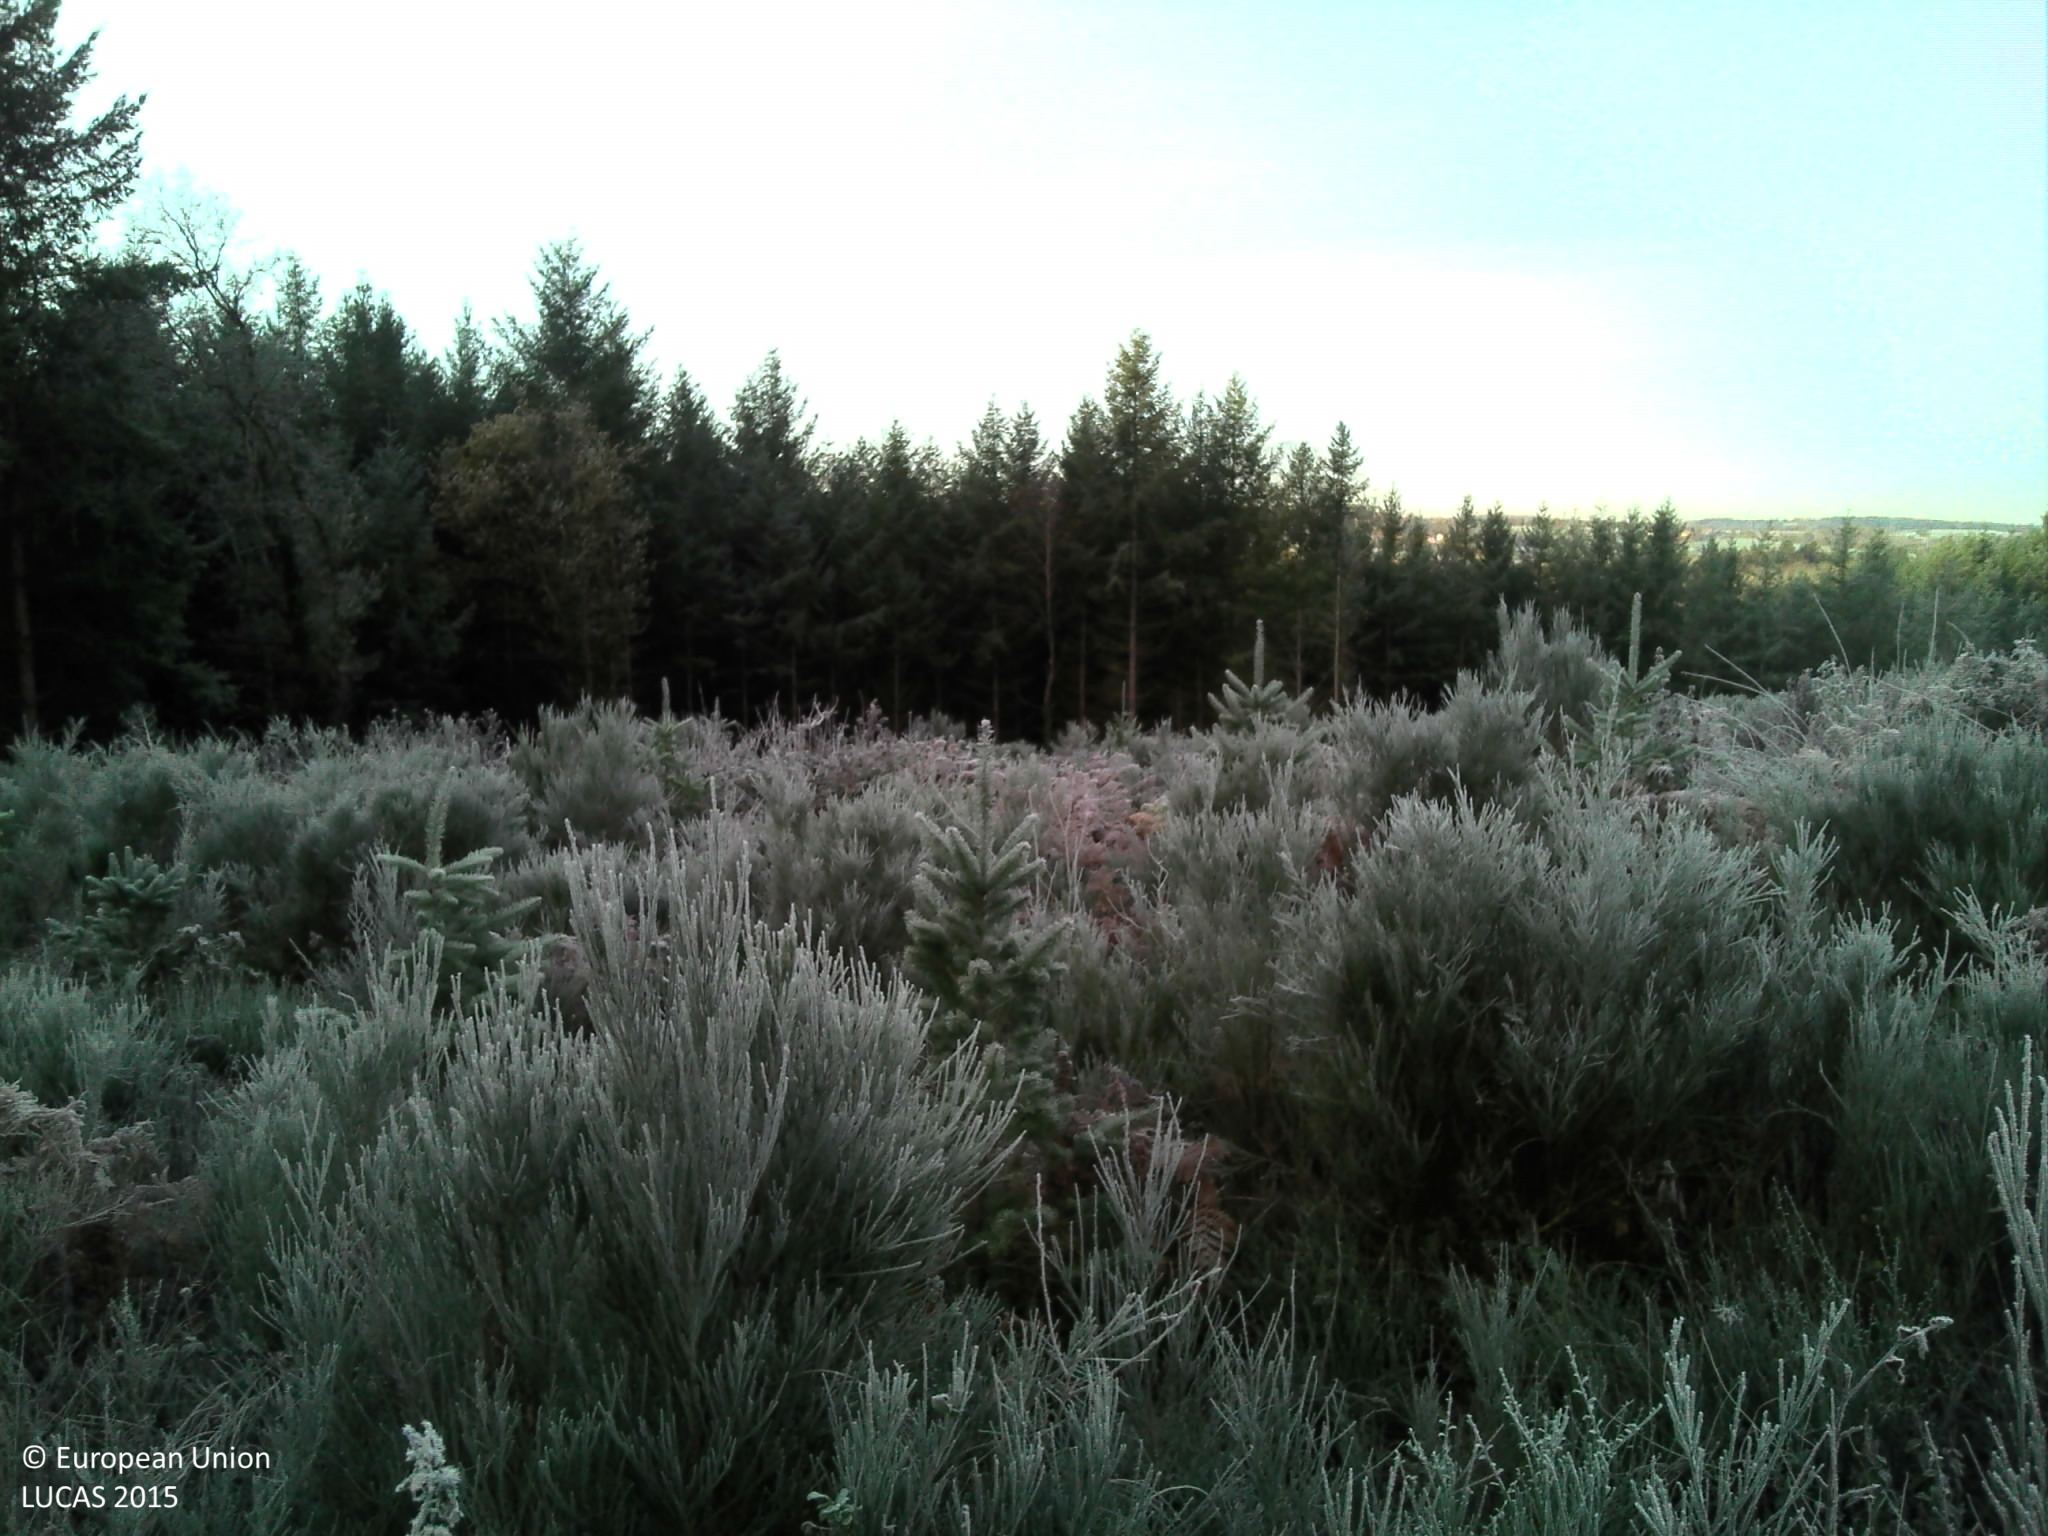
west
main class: Shrubland
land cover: Shrubland with sparse tree cover
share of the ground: > 75 %
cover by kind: shrubs 80 %, herbaceous plants 15 %, coniferous forest trees 5 %
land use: Forestry
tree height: < 5 m
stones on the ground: < 10 %
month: November
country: FR
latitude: 46.1830
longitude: 3.6911
